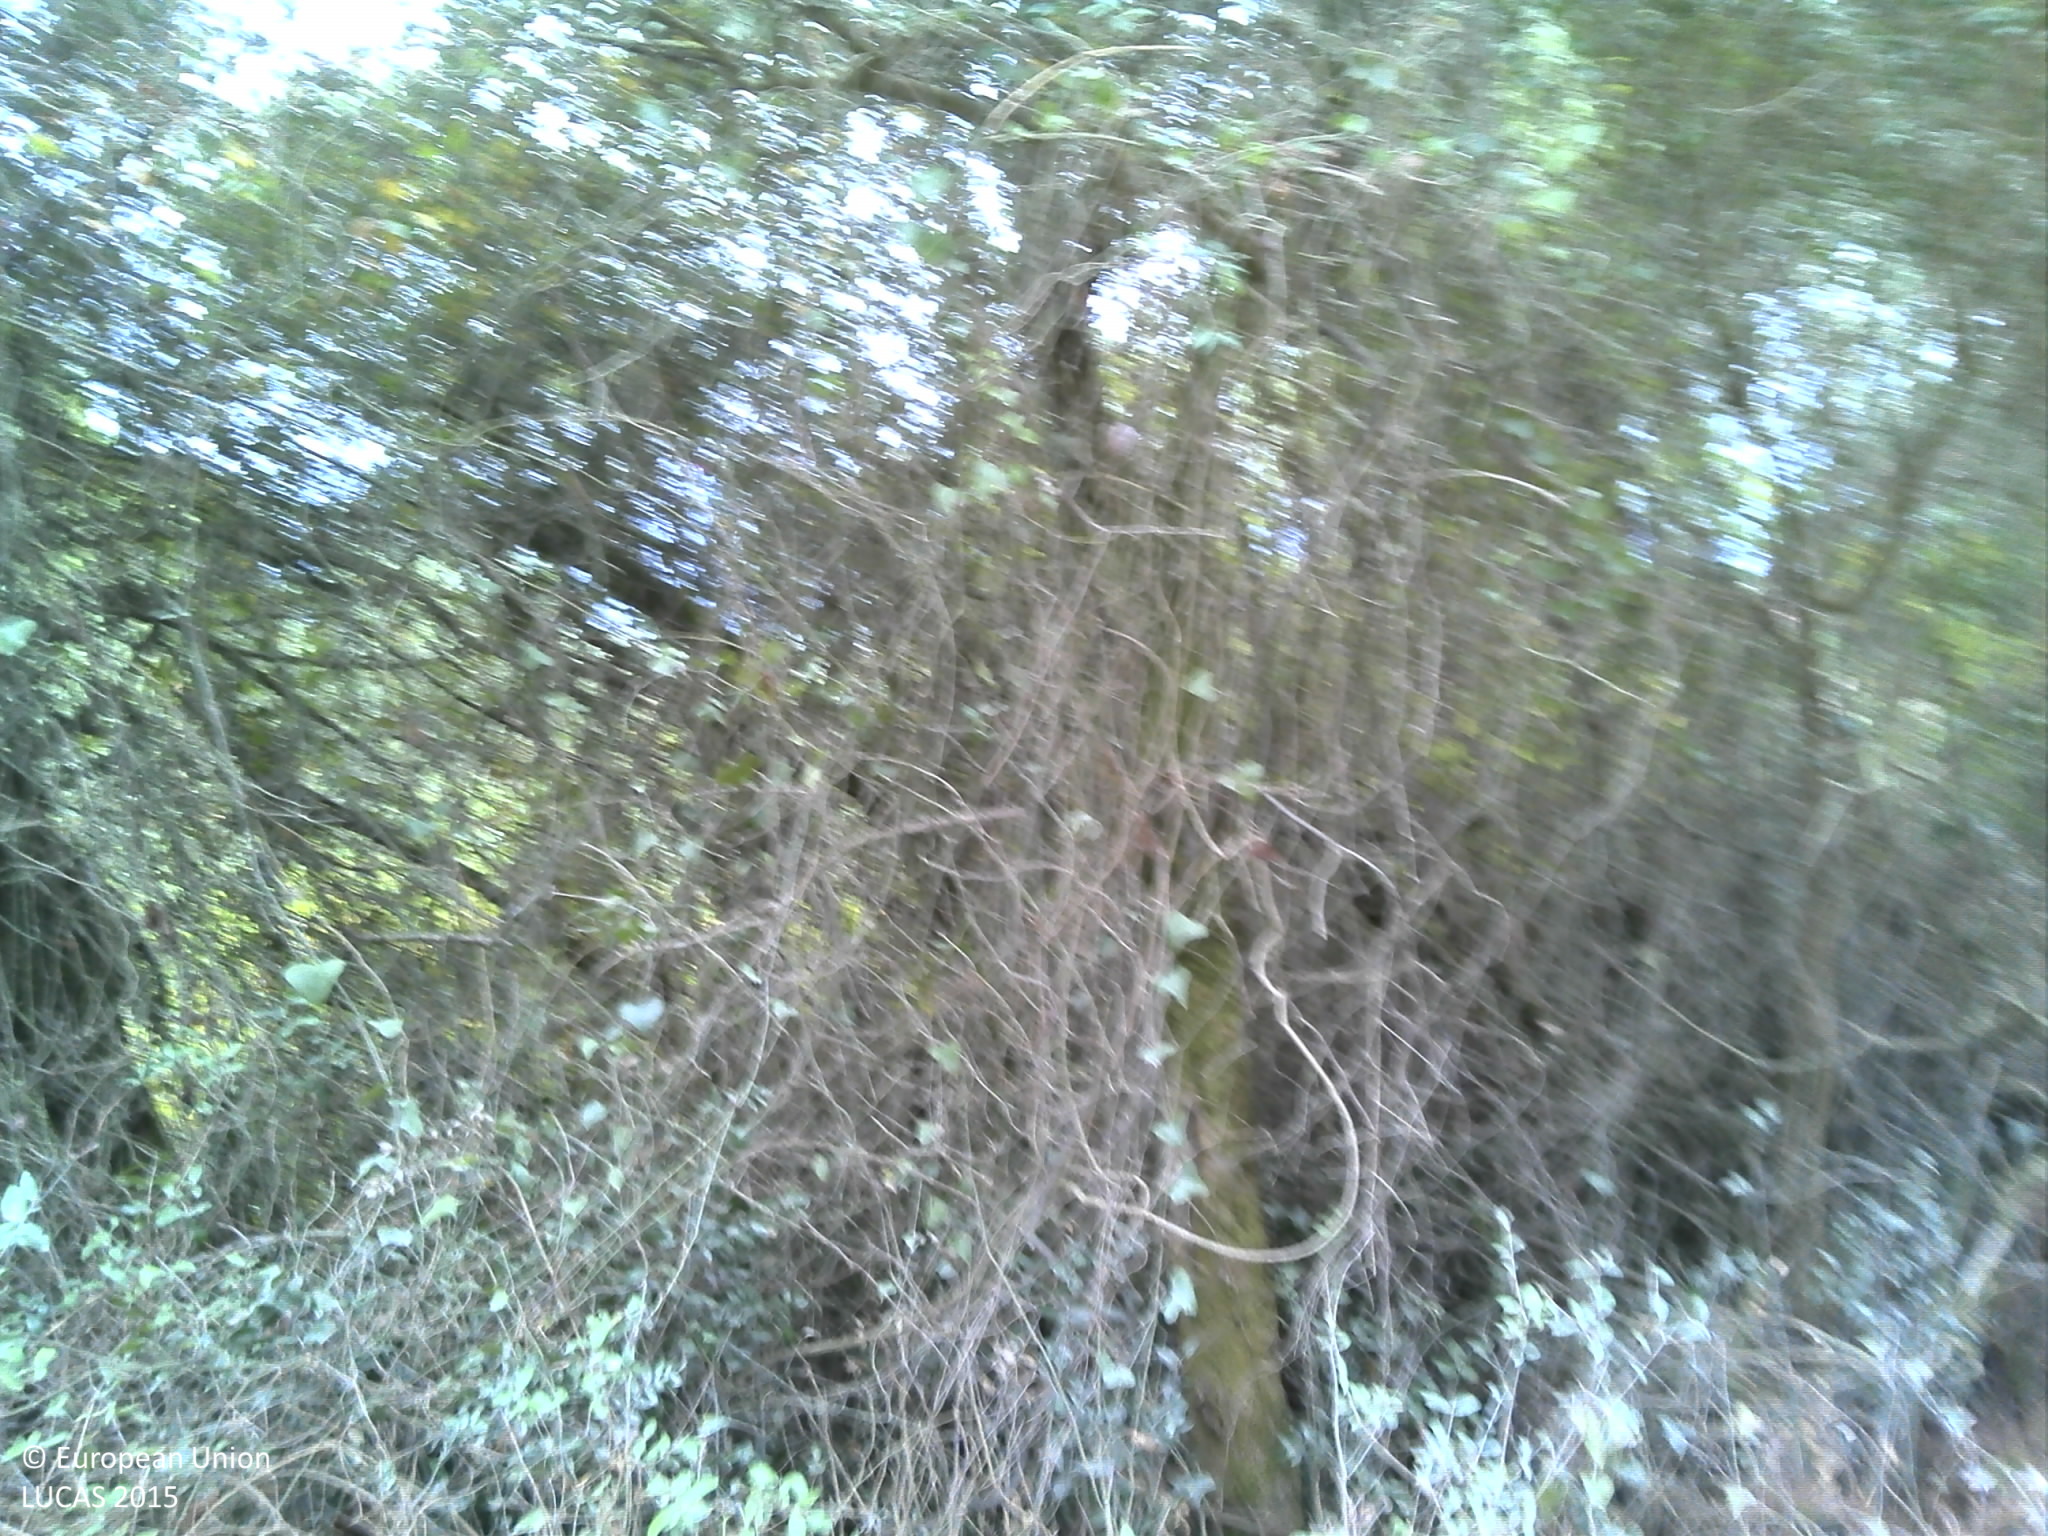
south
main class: Woodland
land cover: Broadleaved woodland
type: broadleaved evergreen forest
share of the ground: 25 - 50 %
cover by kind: broadleaved forest trees 40 %, shrubs 40 %, unconsolidated bare surface 20 %
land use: Forestry
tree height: > 5 m
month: August
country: PT
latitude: 38.8285
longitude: -9.4024
